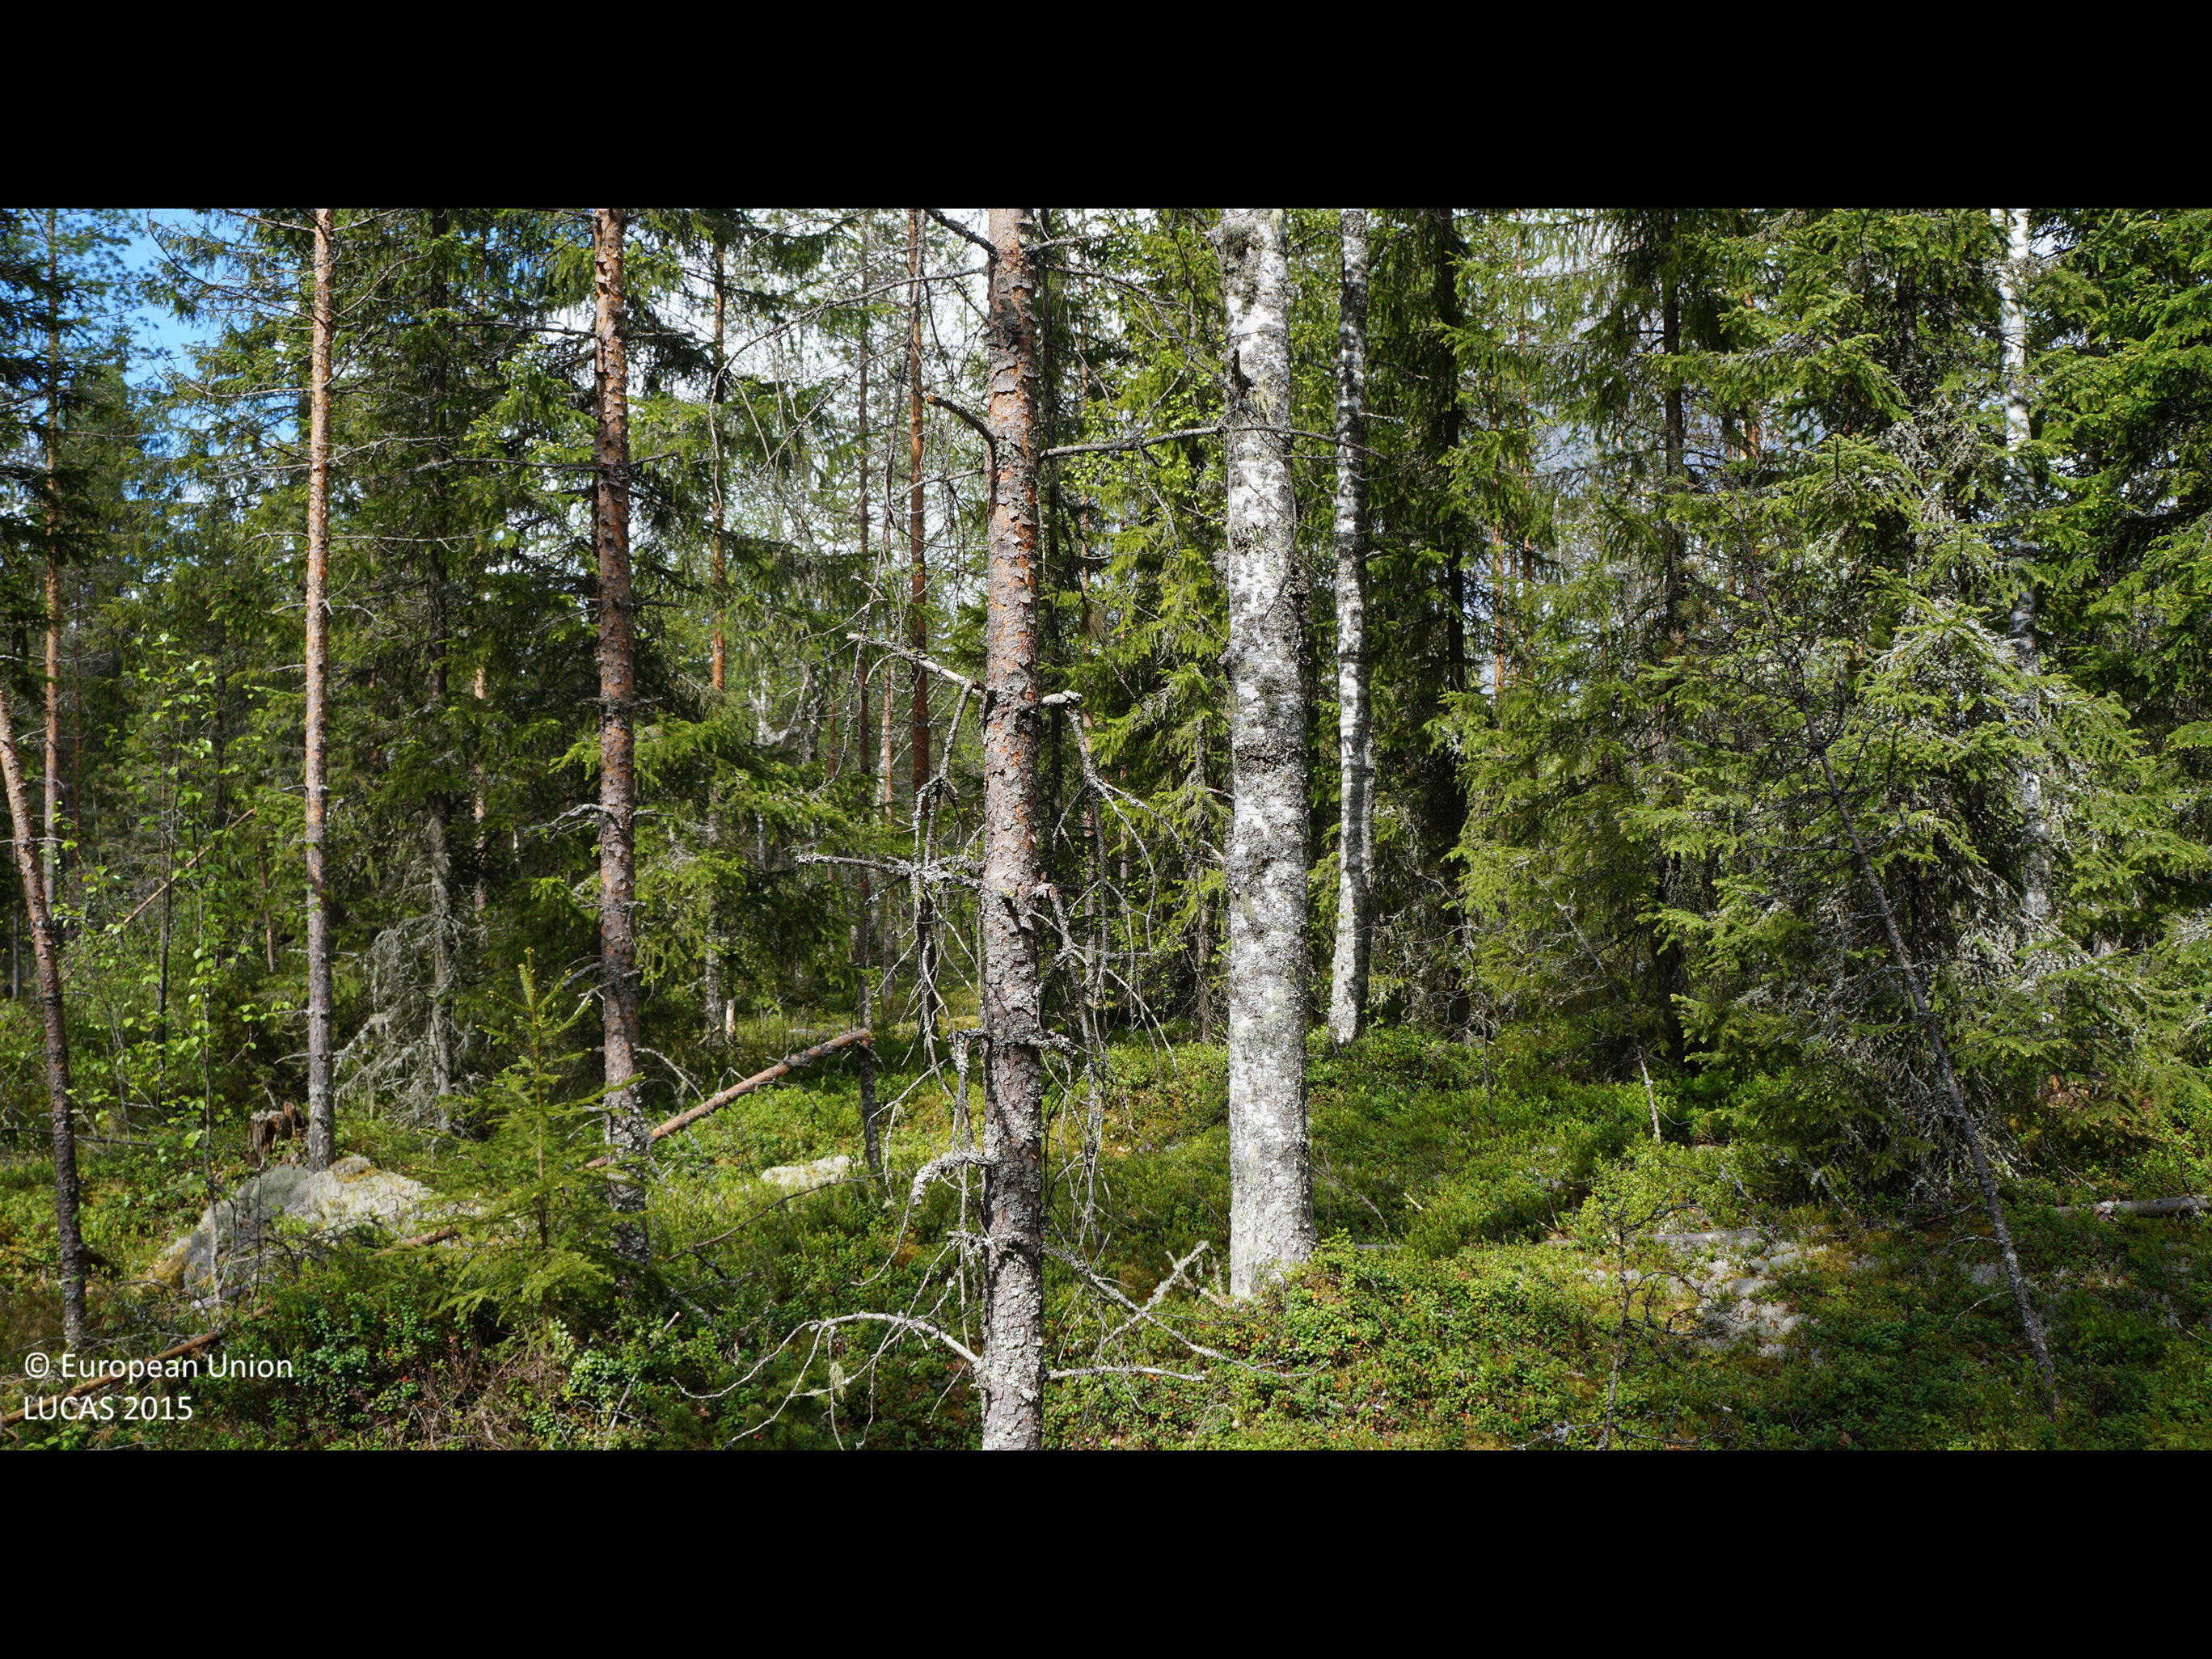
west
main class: Woodland
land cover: Pine dominated mixed woodland
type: boreal forest
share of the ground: 50 - 75 %
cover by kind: coniferous forest trees 40 %, shrubs 25 %, broadleaved forest trees 20 %, lichens and mosses 15 %
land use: Forestry
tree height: > 5 m
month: June
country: FI
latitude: 63.8045
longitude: 24.2649
